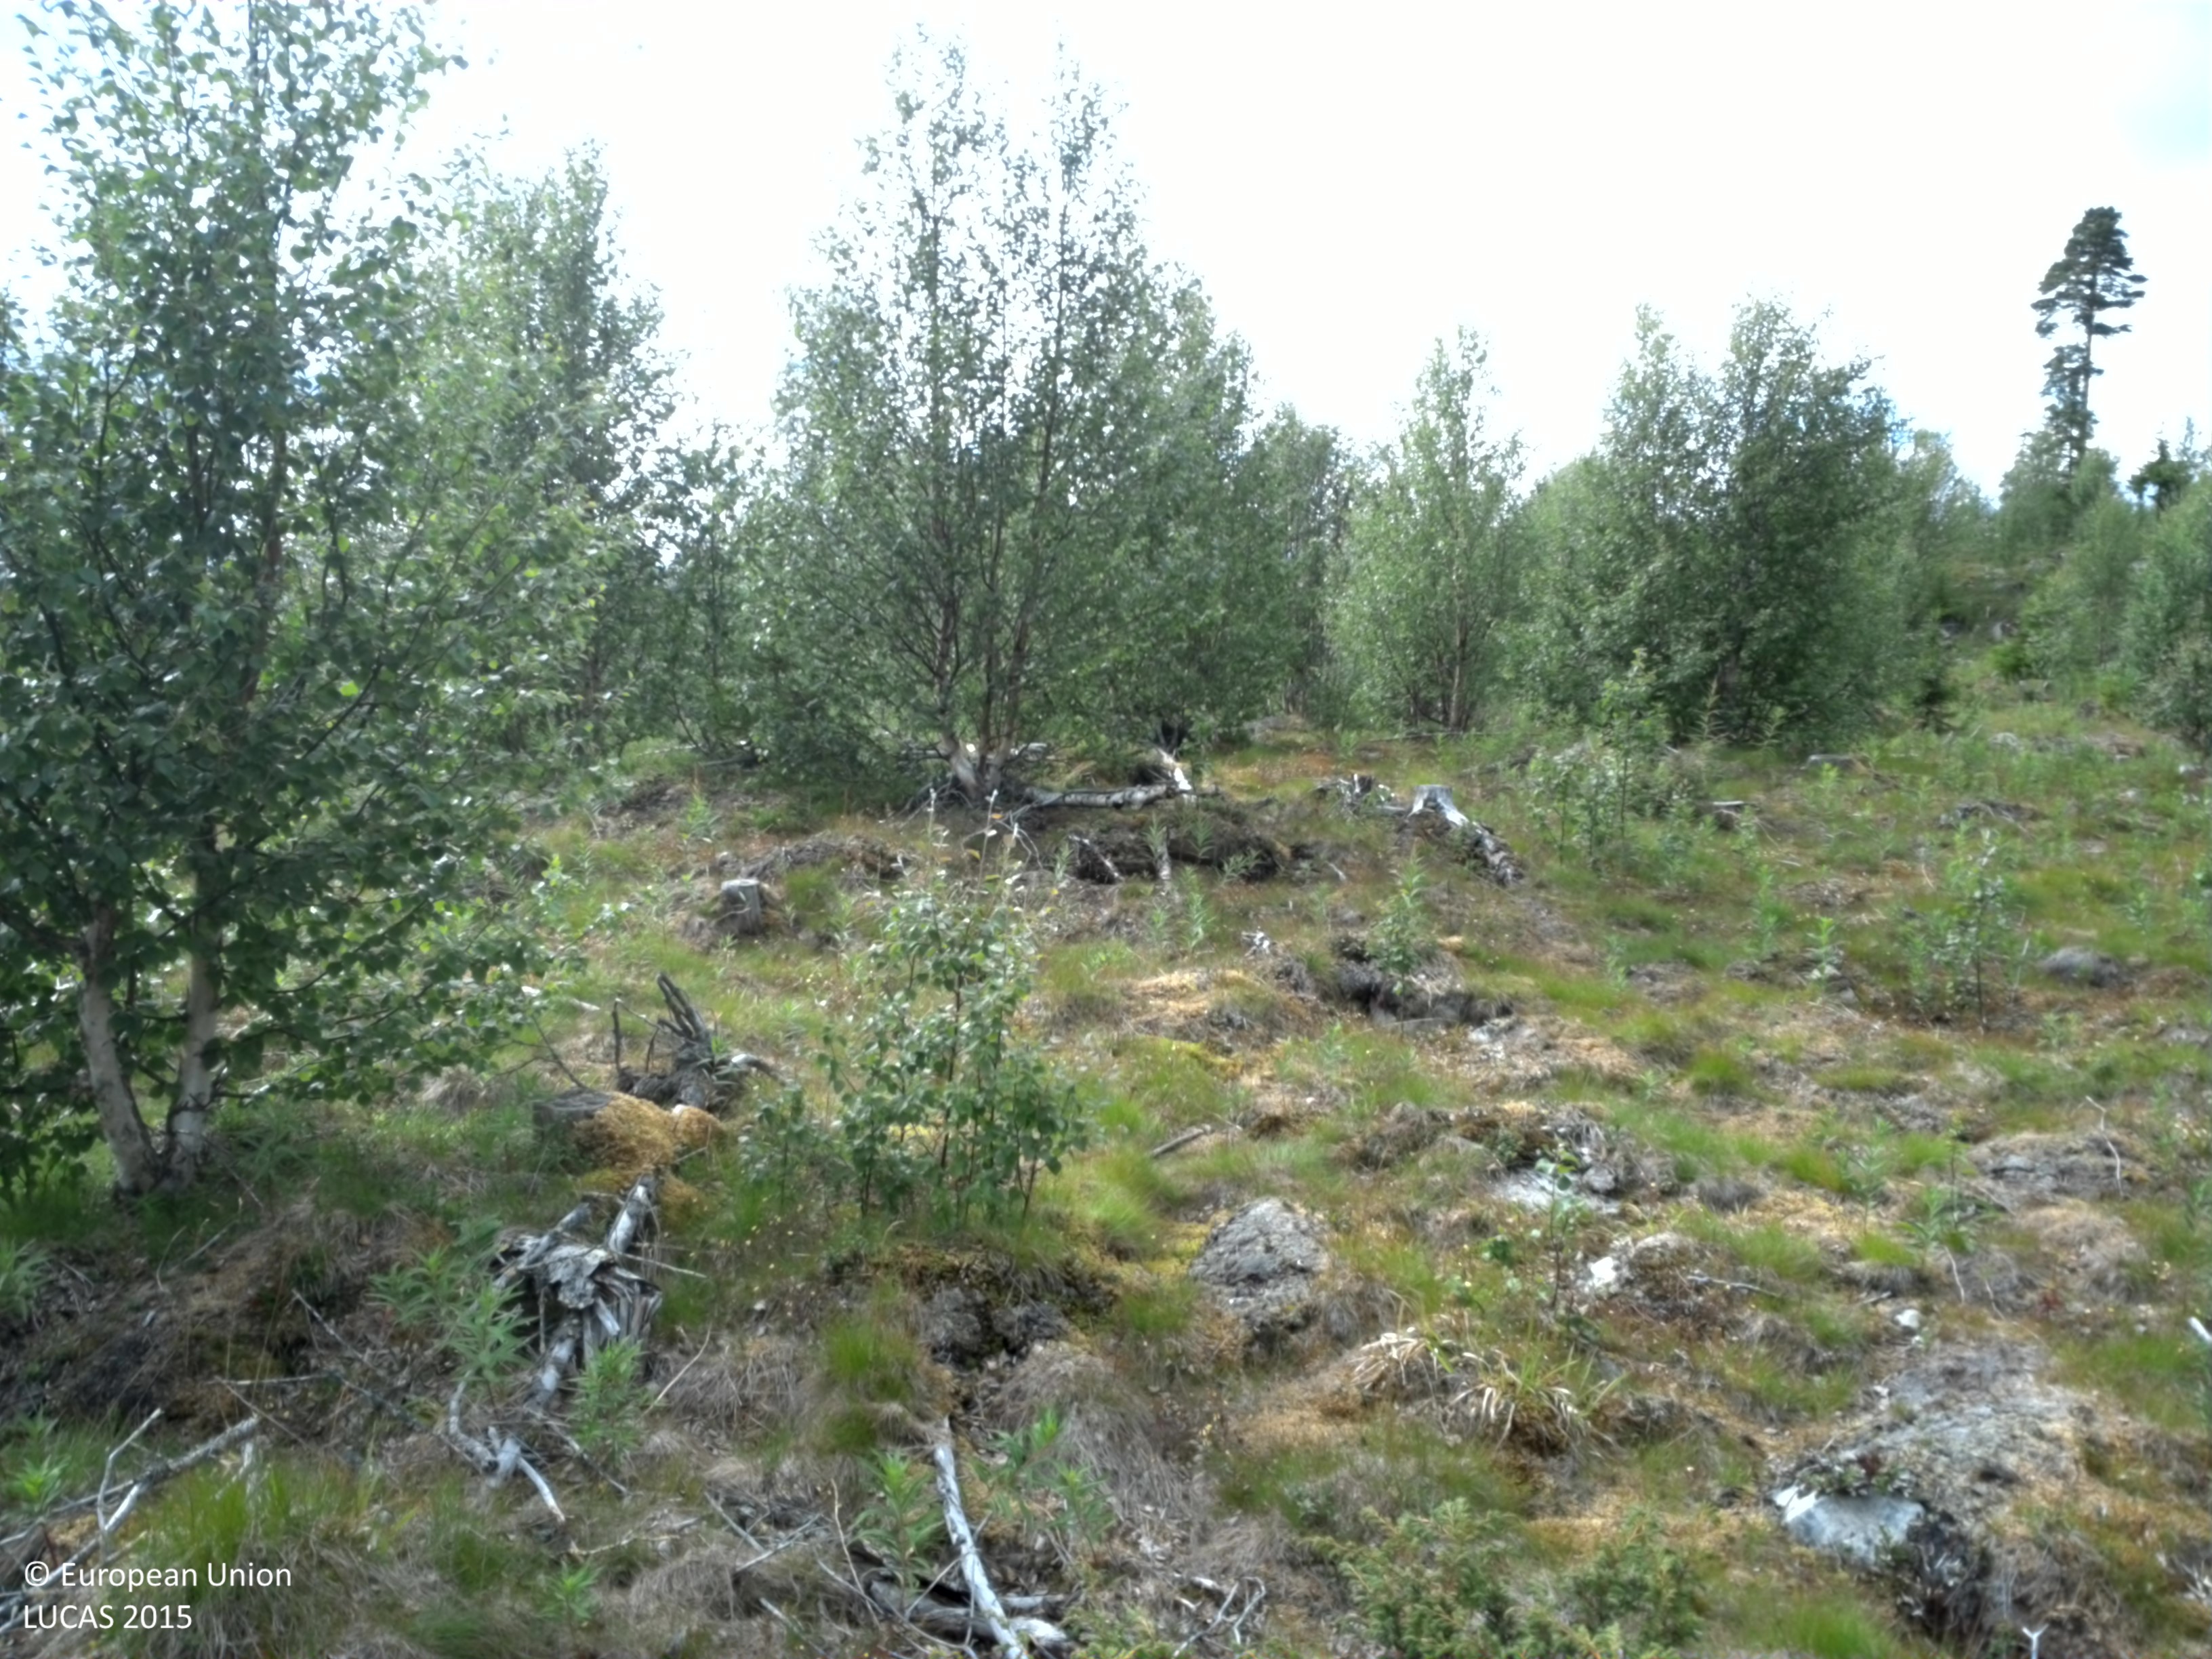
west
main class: Woodland
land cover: Broadleaved woodland
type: non-riverine alder, birch or aspen forest
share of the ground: 10 - 25 %
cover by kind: herbaceous plants 60 %, lichens and mosses 20 %, broadleaved forest trees 10 %, shrubs 10 %
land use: Forestry
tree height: < 5 m
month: August
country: SE
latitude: 65.2325
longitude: 15.8480
